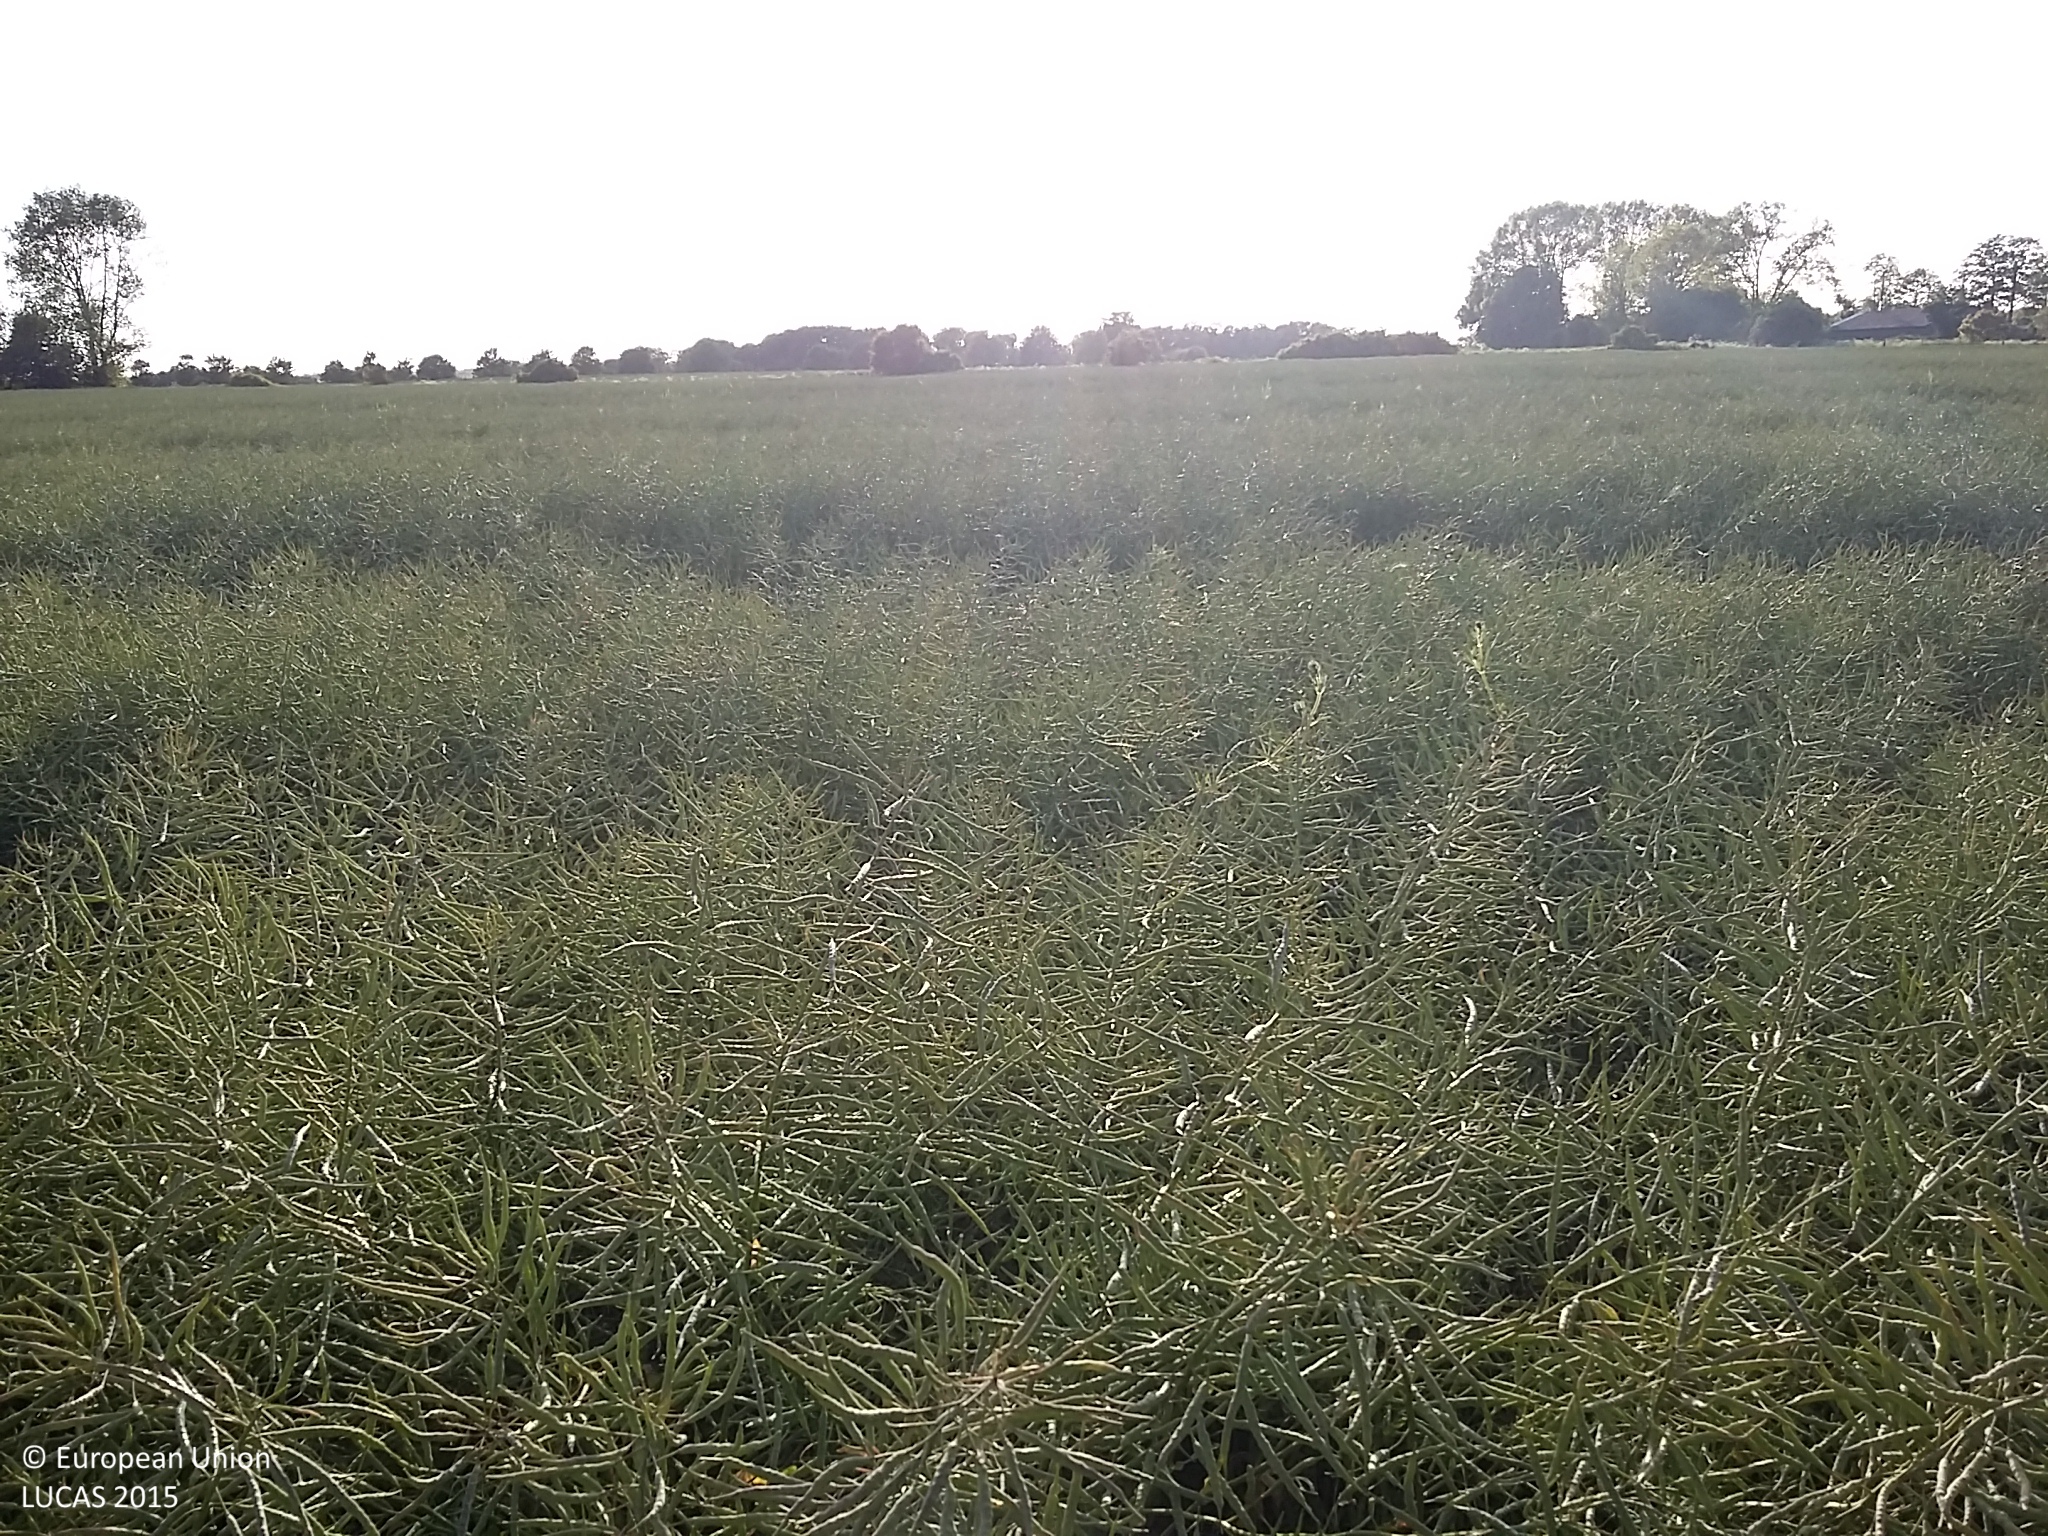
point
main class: Cropland
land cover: Rape and turnip rape
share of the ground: > 75 %
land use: Agriculture (excluding fallow land and kitchen gardens)
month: June
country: DK
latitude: 55.2150
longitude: 10.7381
